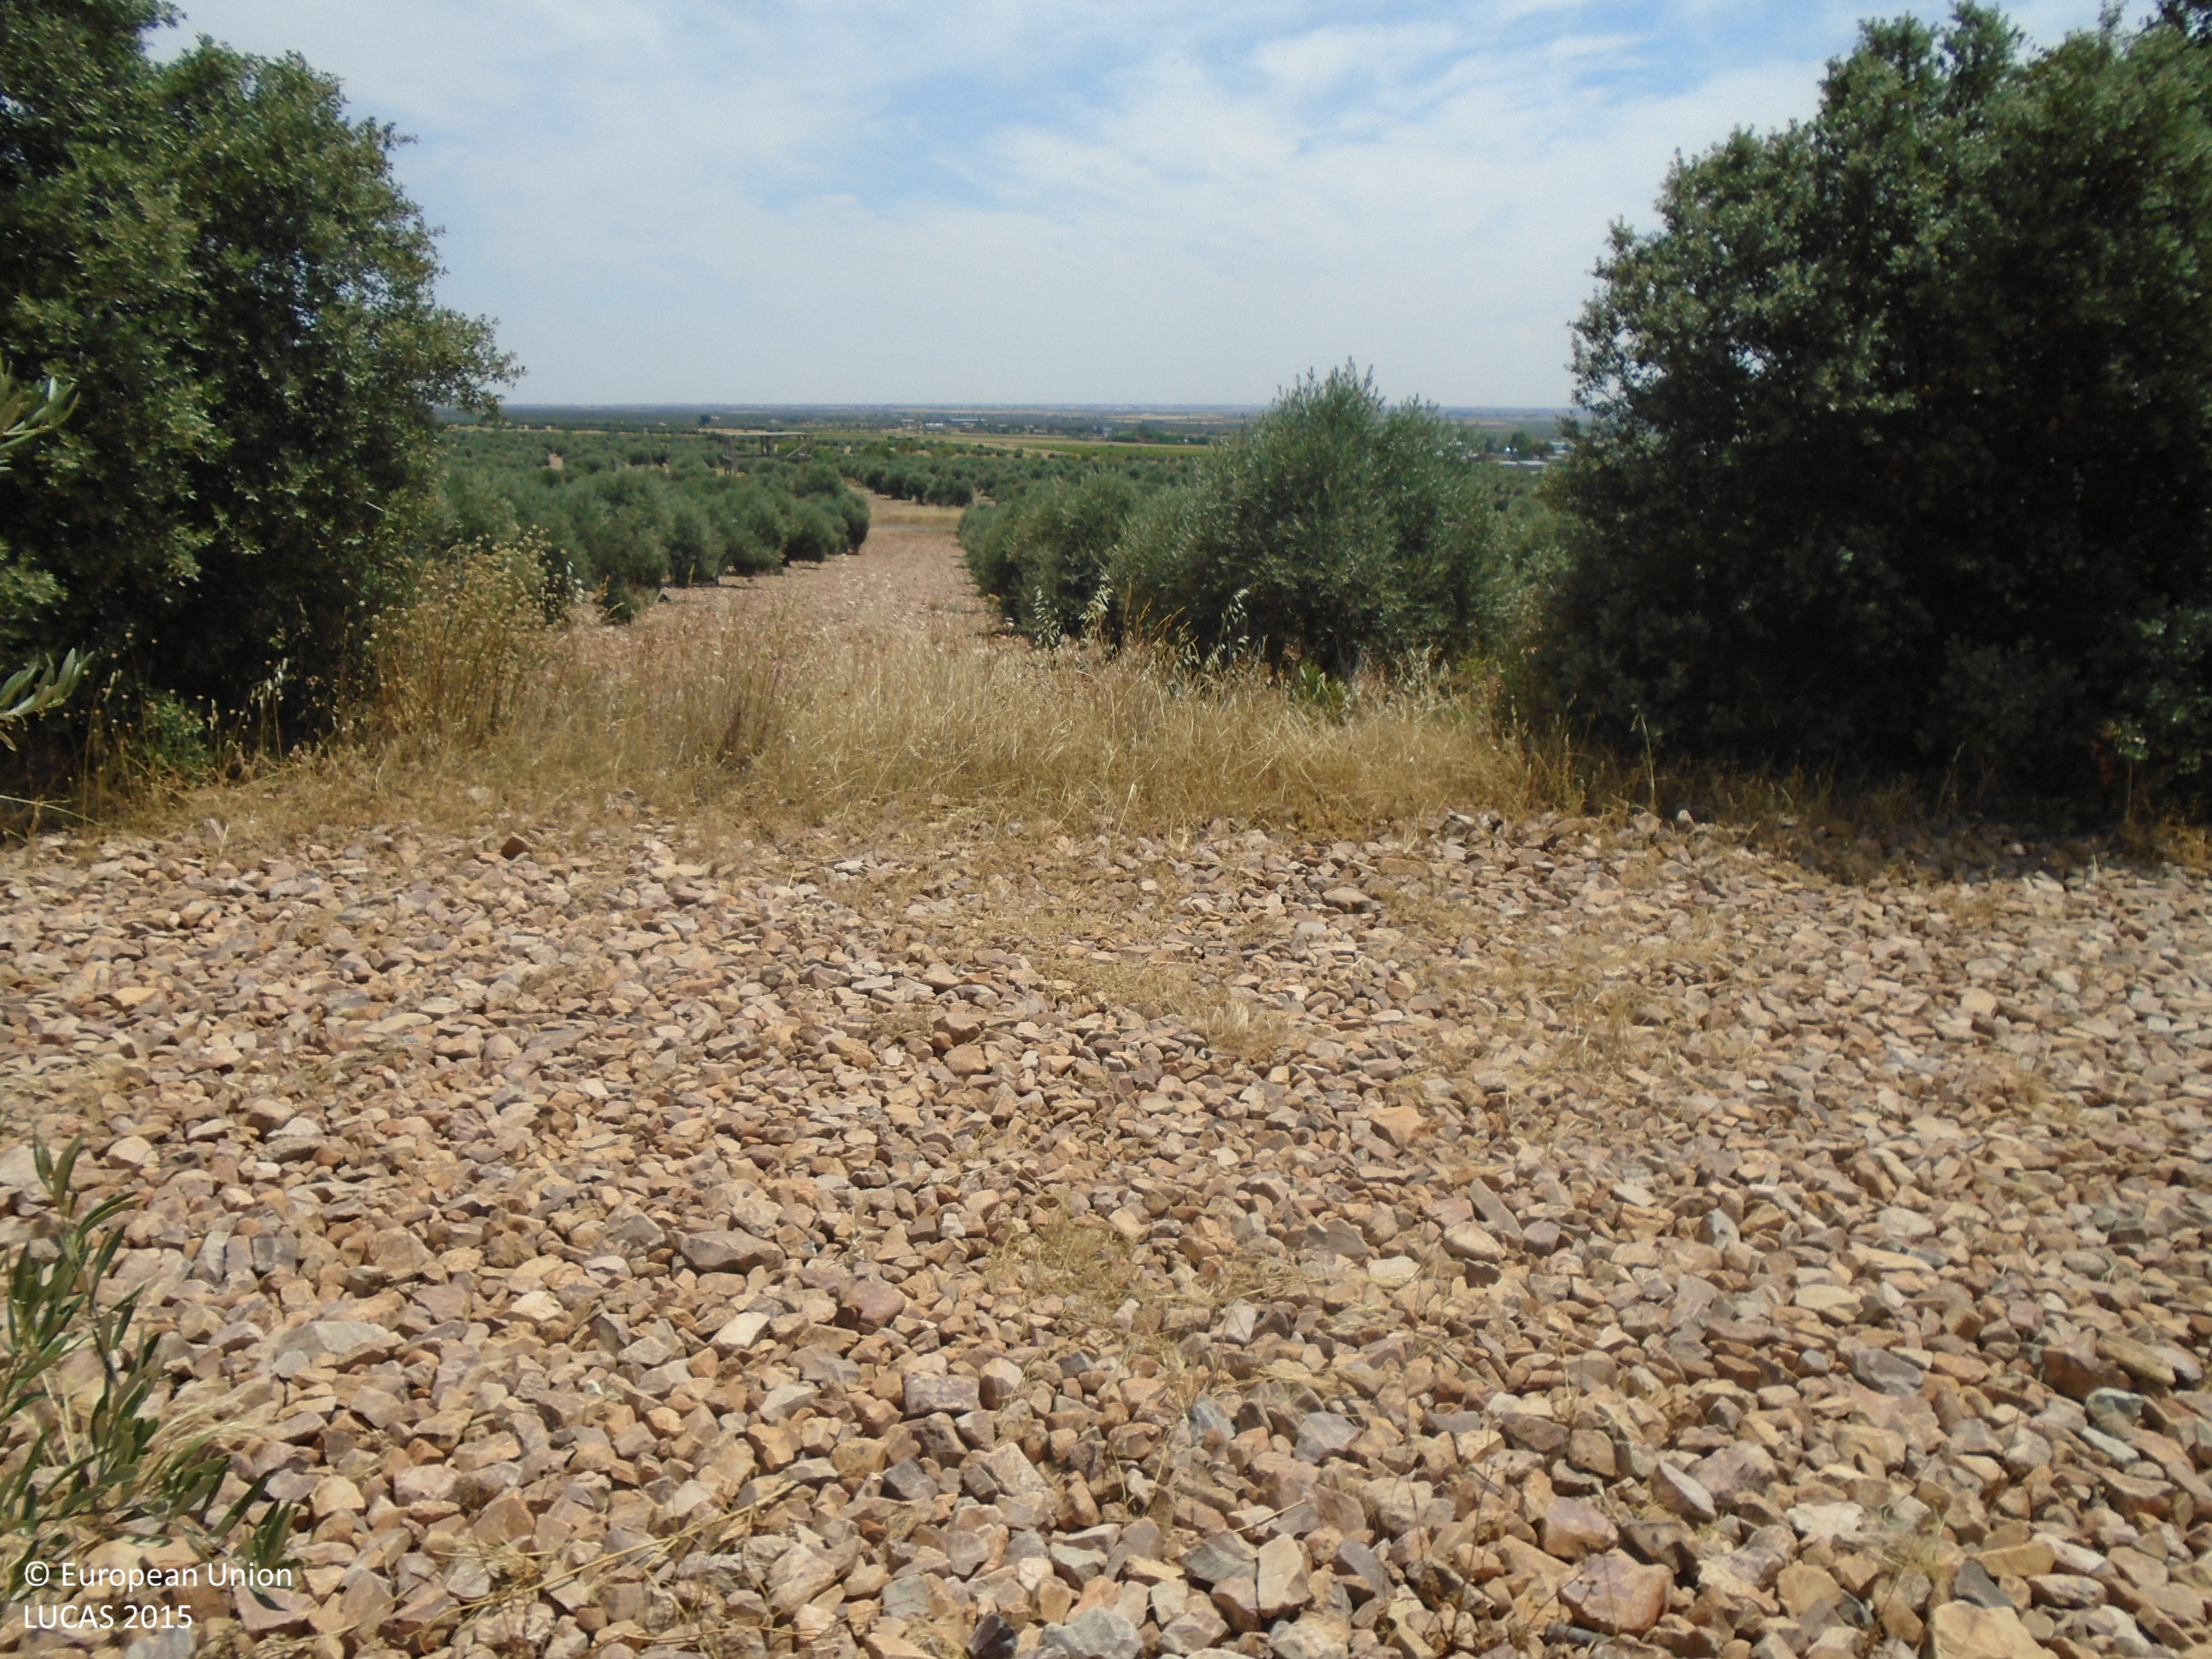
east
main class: Cropland
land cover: Olive groves
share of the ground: 10 - 25 %
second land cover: Other bare soil
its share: > 75 %
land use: Agriculture (excluding fallow land and kitchen gardens)
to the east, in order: Olive groves; Other bare soil; Grassland without tree/shrub cover; Olive groves; Grass margins; Paved roads, cycling and walking lanes; Grassland without tree/shrub cover; Tracks; Fences; Olive groves; Vineyards
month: June
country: ES
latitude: 39.2406
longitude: -3.6108
